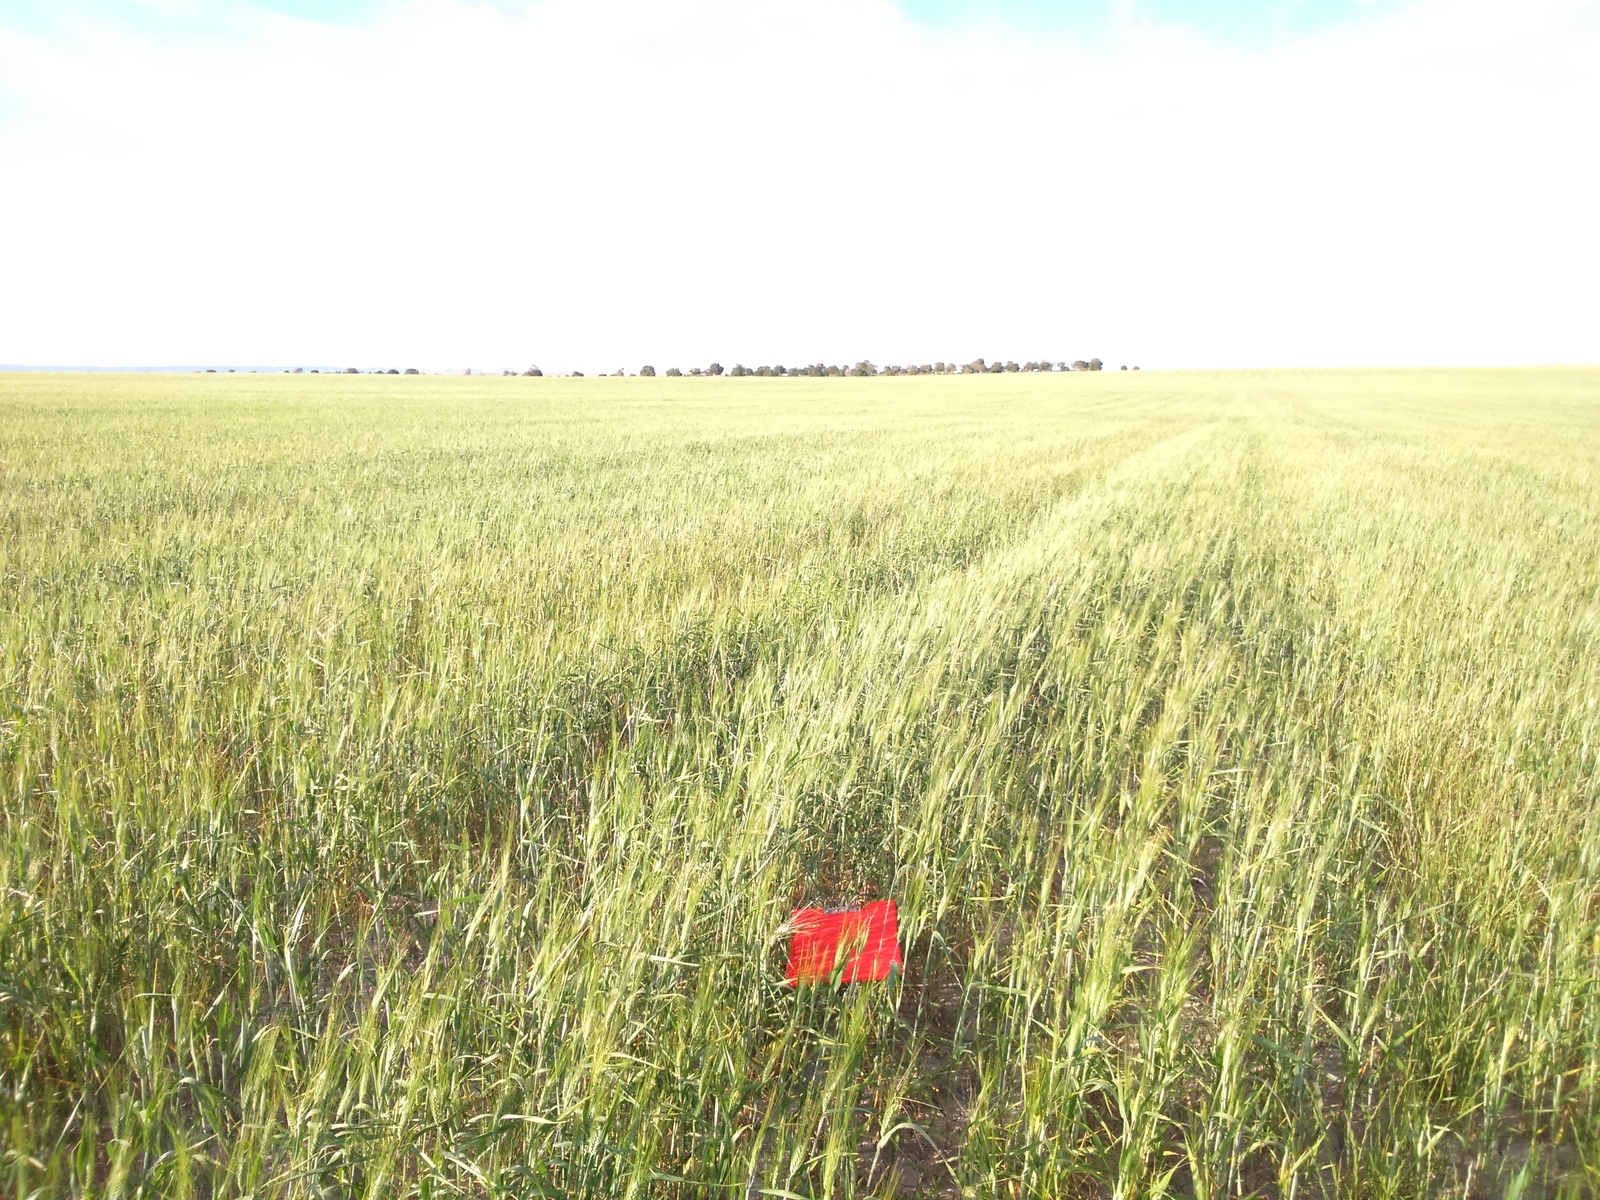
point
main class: Cropland
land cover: Durum wheat
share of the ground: > 75 %
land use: Agriculture (excluding fallow land and kitchen gardens)
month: April
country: ES
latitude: 41.4389
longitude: -0.2724
